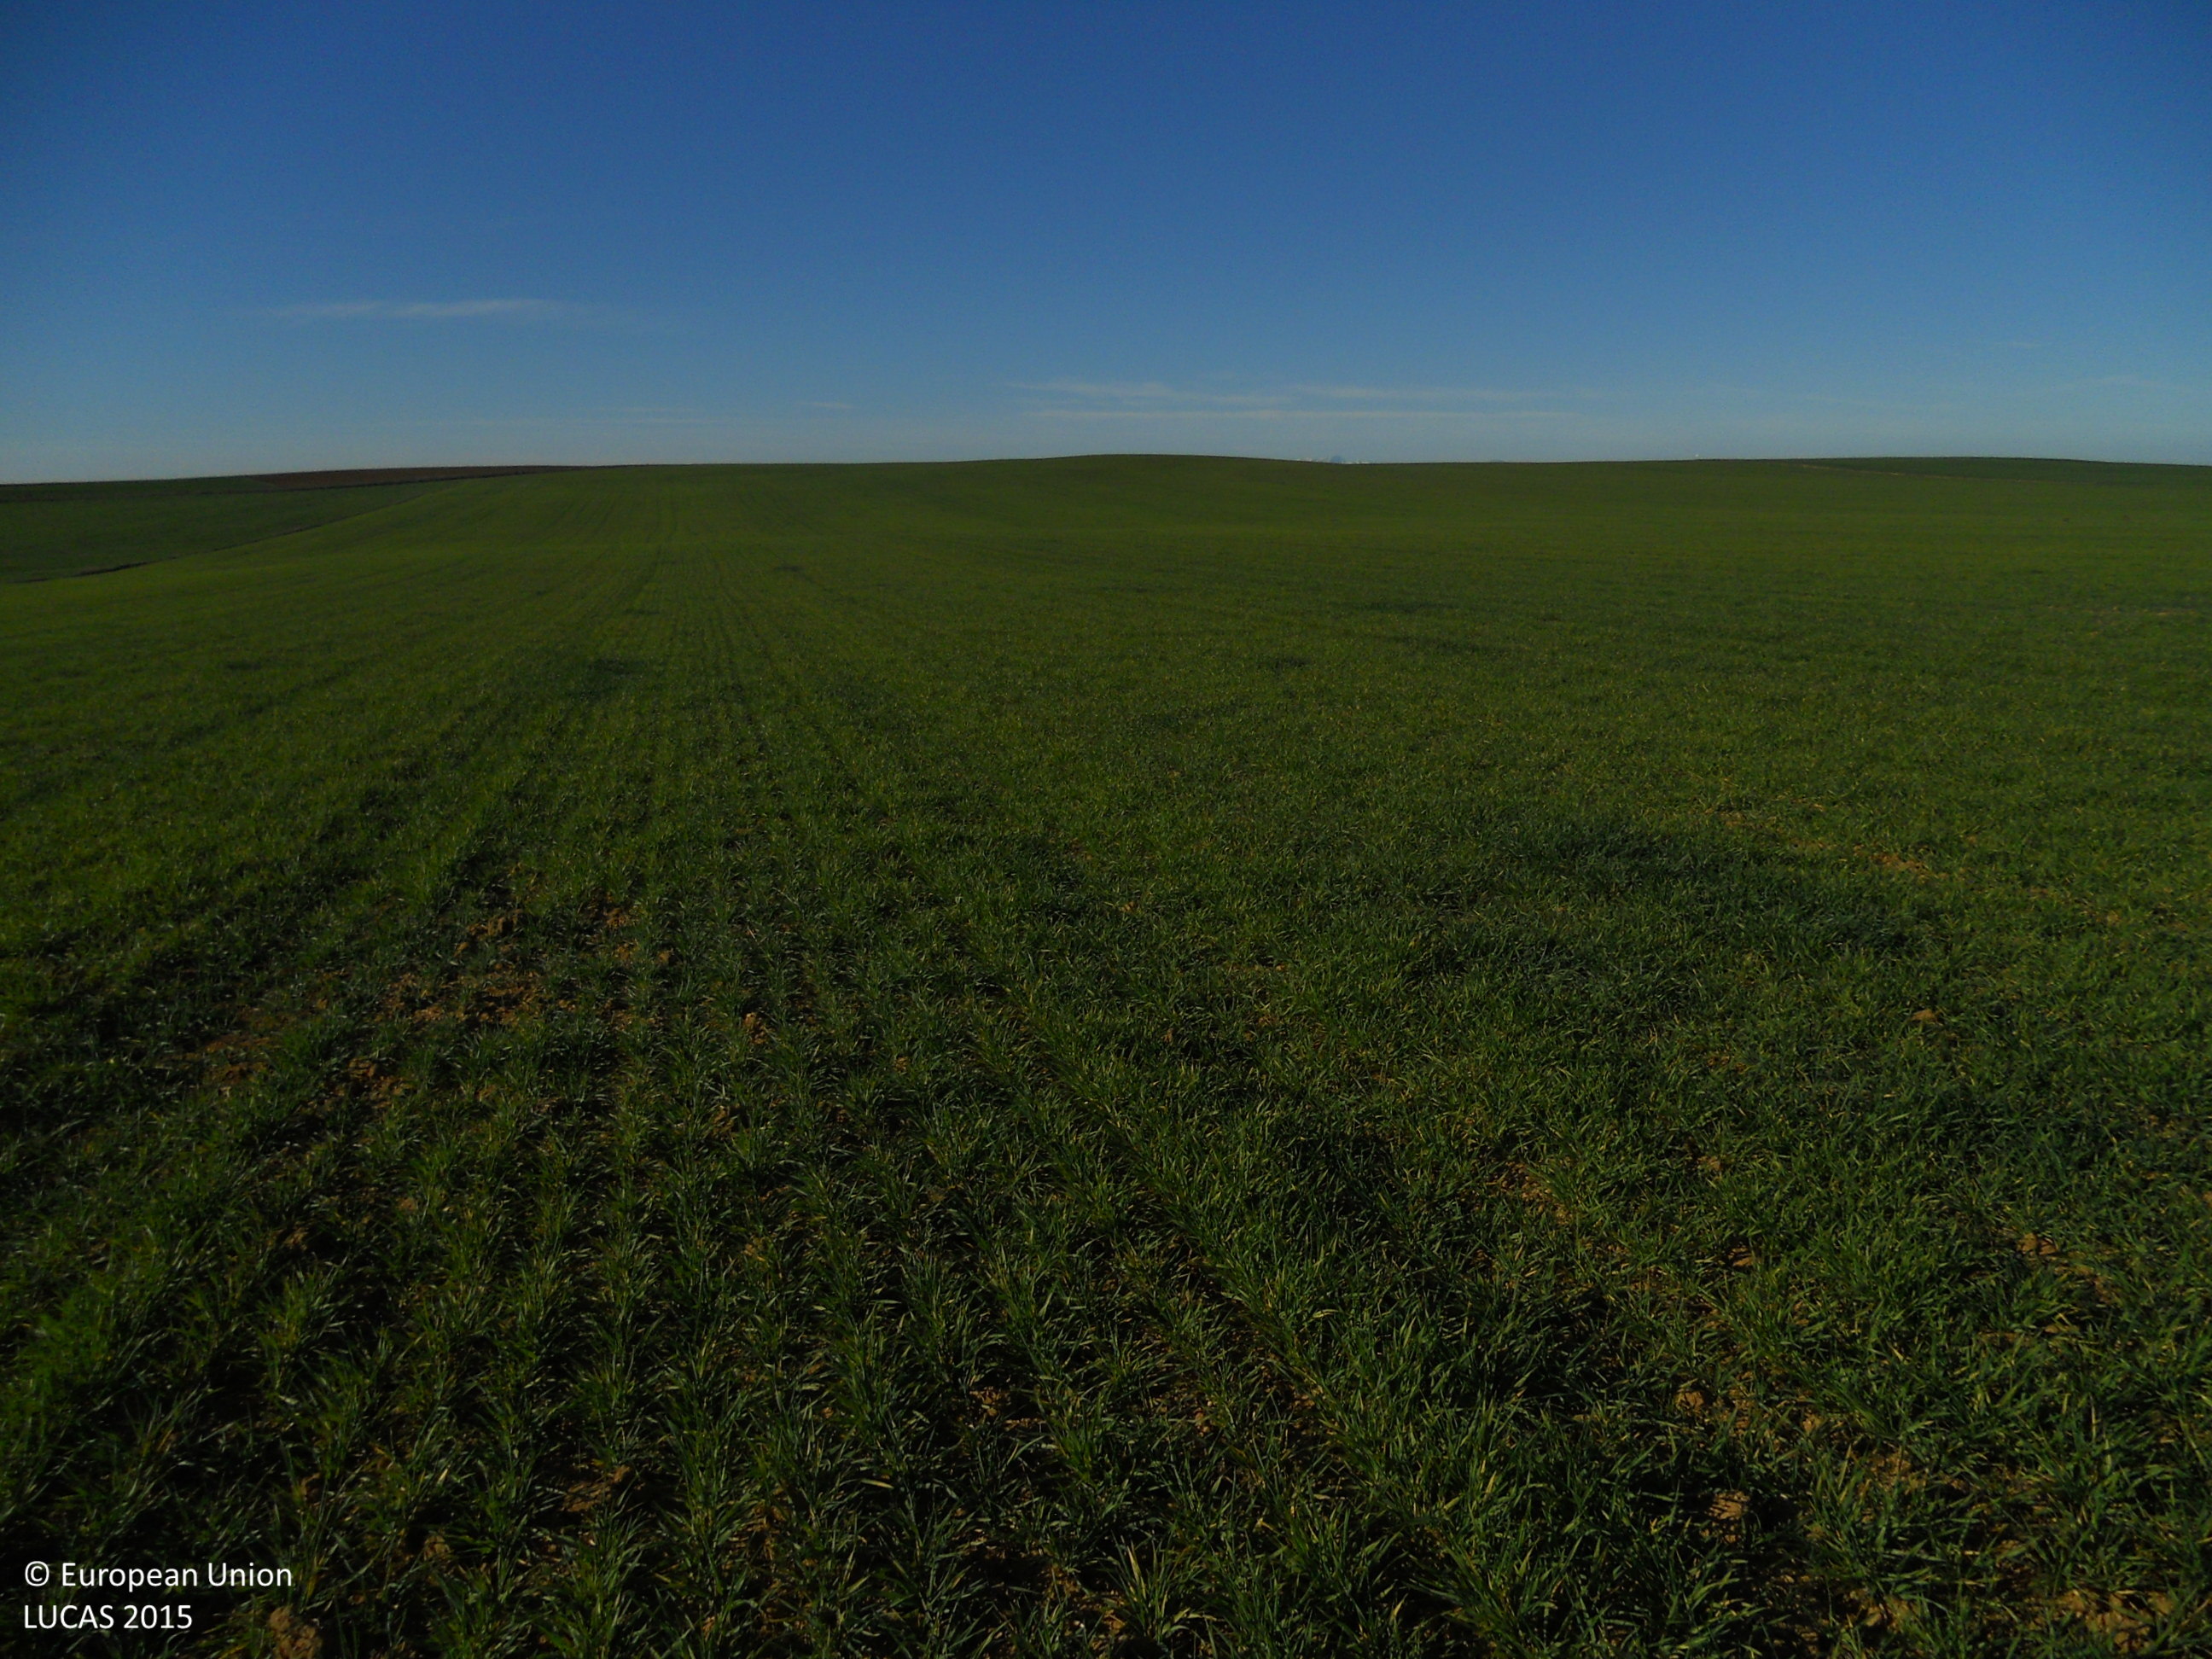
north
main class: Cropland
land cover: Barley
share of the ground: > 75 %
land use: Agriculture (excluding fallow land and kitchen gardens)
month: March
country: ES
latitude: 42.1813
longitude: -4.8117
